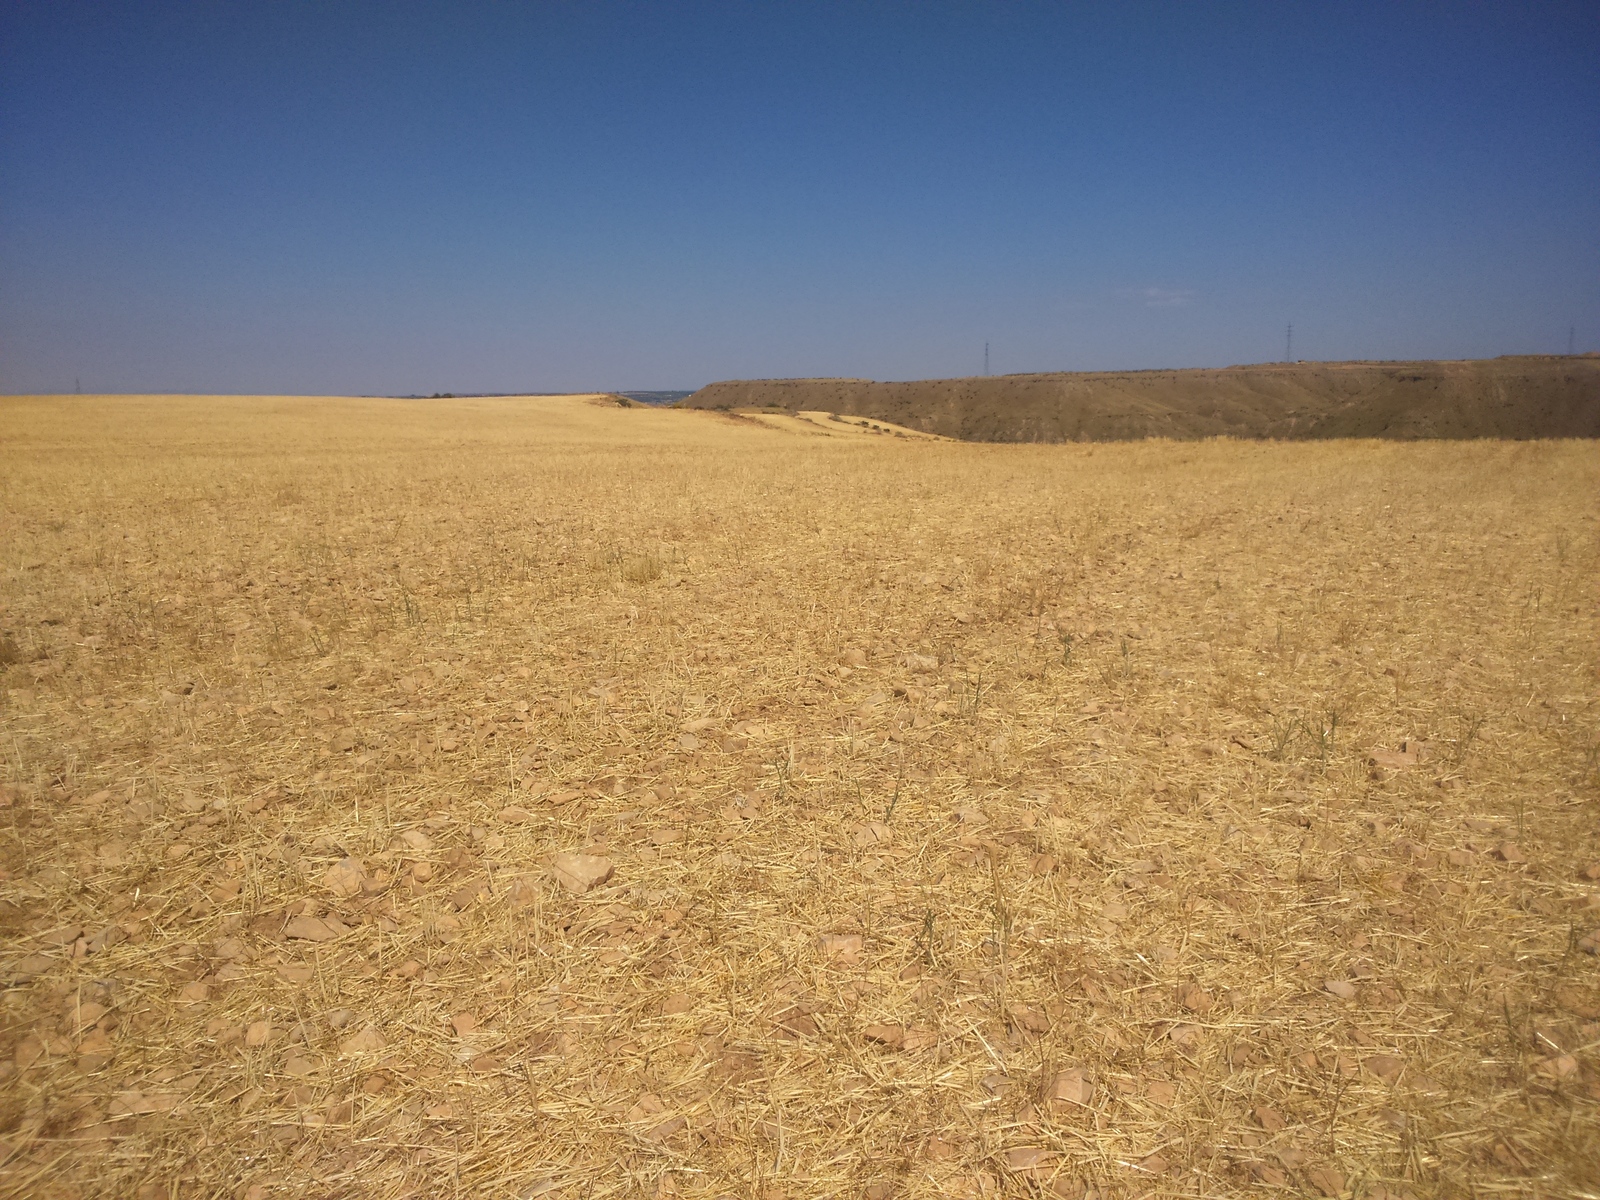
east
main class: Cropland
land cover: Barley
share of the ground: < 10 %
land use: Agriculture (excluding fallow land and kitchen gardens)
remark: Harvested field
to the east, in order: Barley; Shruby margins; Barley; Shruby margins; Barley; Shruby margins; Barley
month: June
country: ES
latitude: 41.6588
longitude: 0.1014
